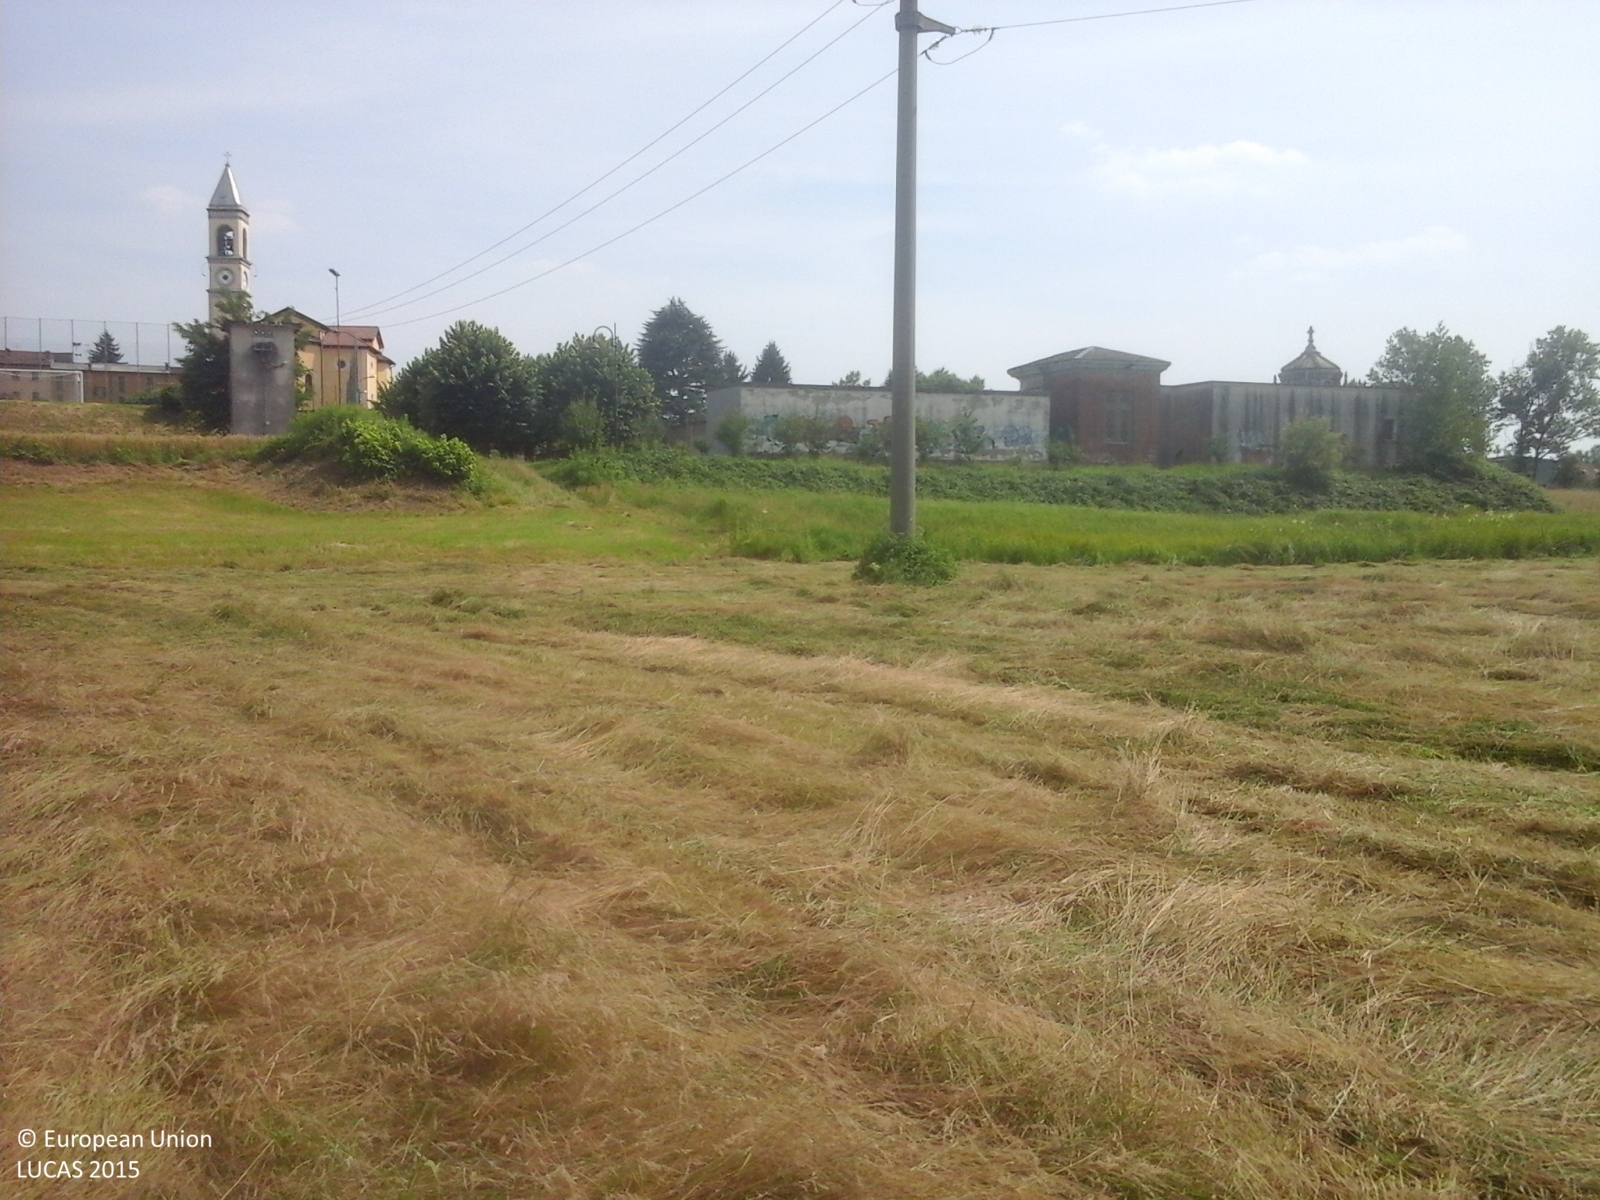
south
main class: Grassland
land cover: Grassland without tree/shrub cover
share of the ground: > 75 %
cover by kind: herbaceous plants 100 %
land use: Agriculture (excluding fallow land and kitchen gardens)
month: June
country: IT
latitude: 45.7183
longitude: 9.2945
